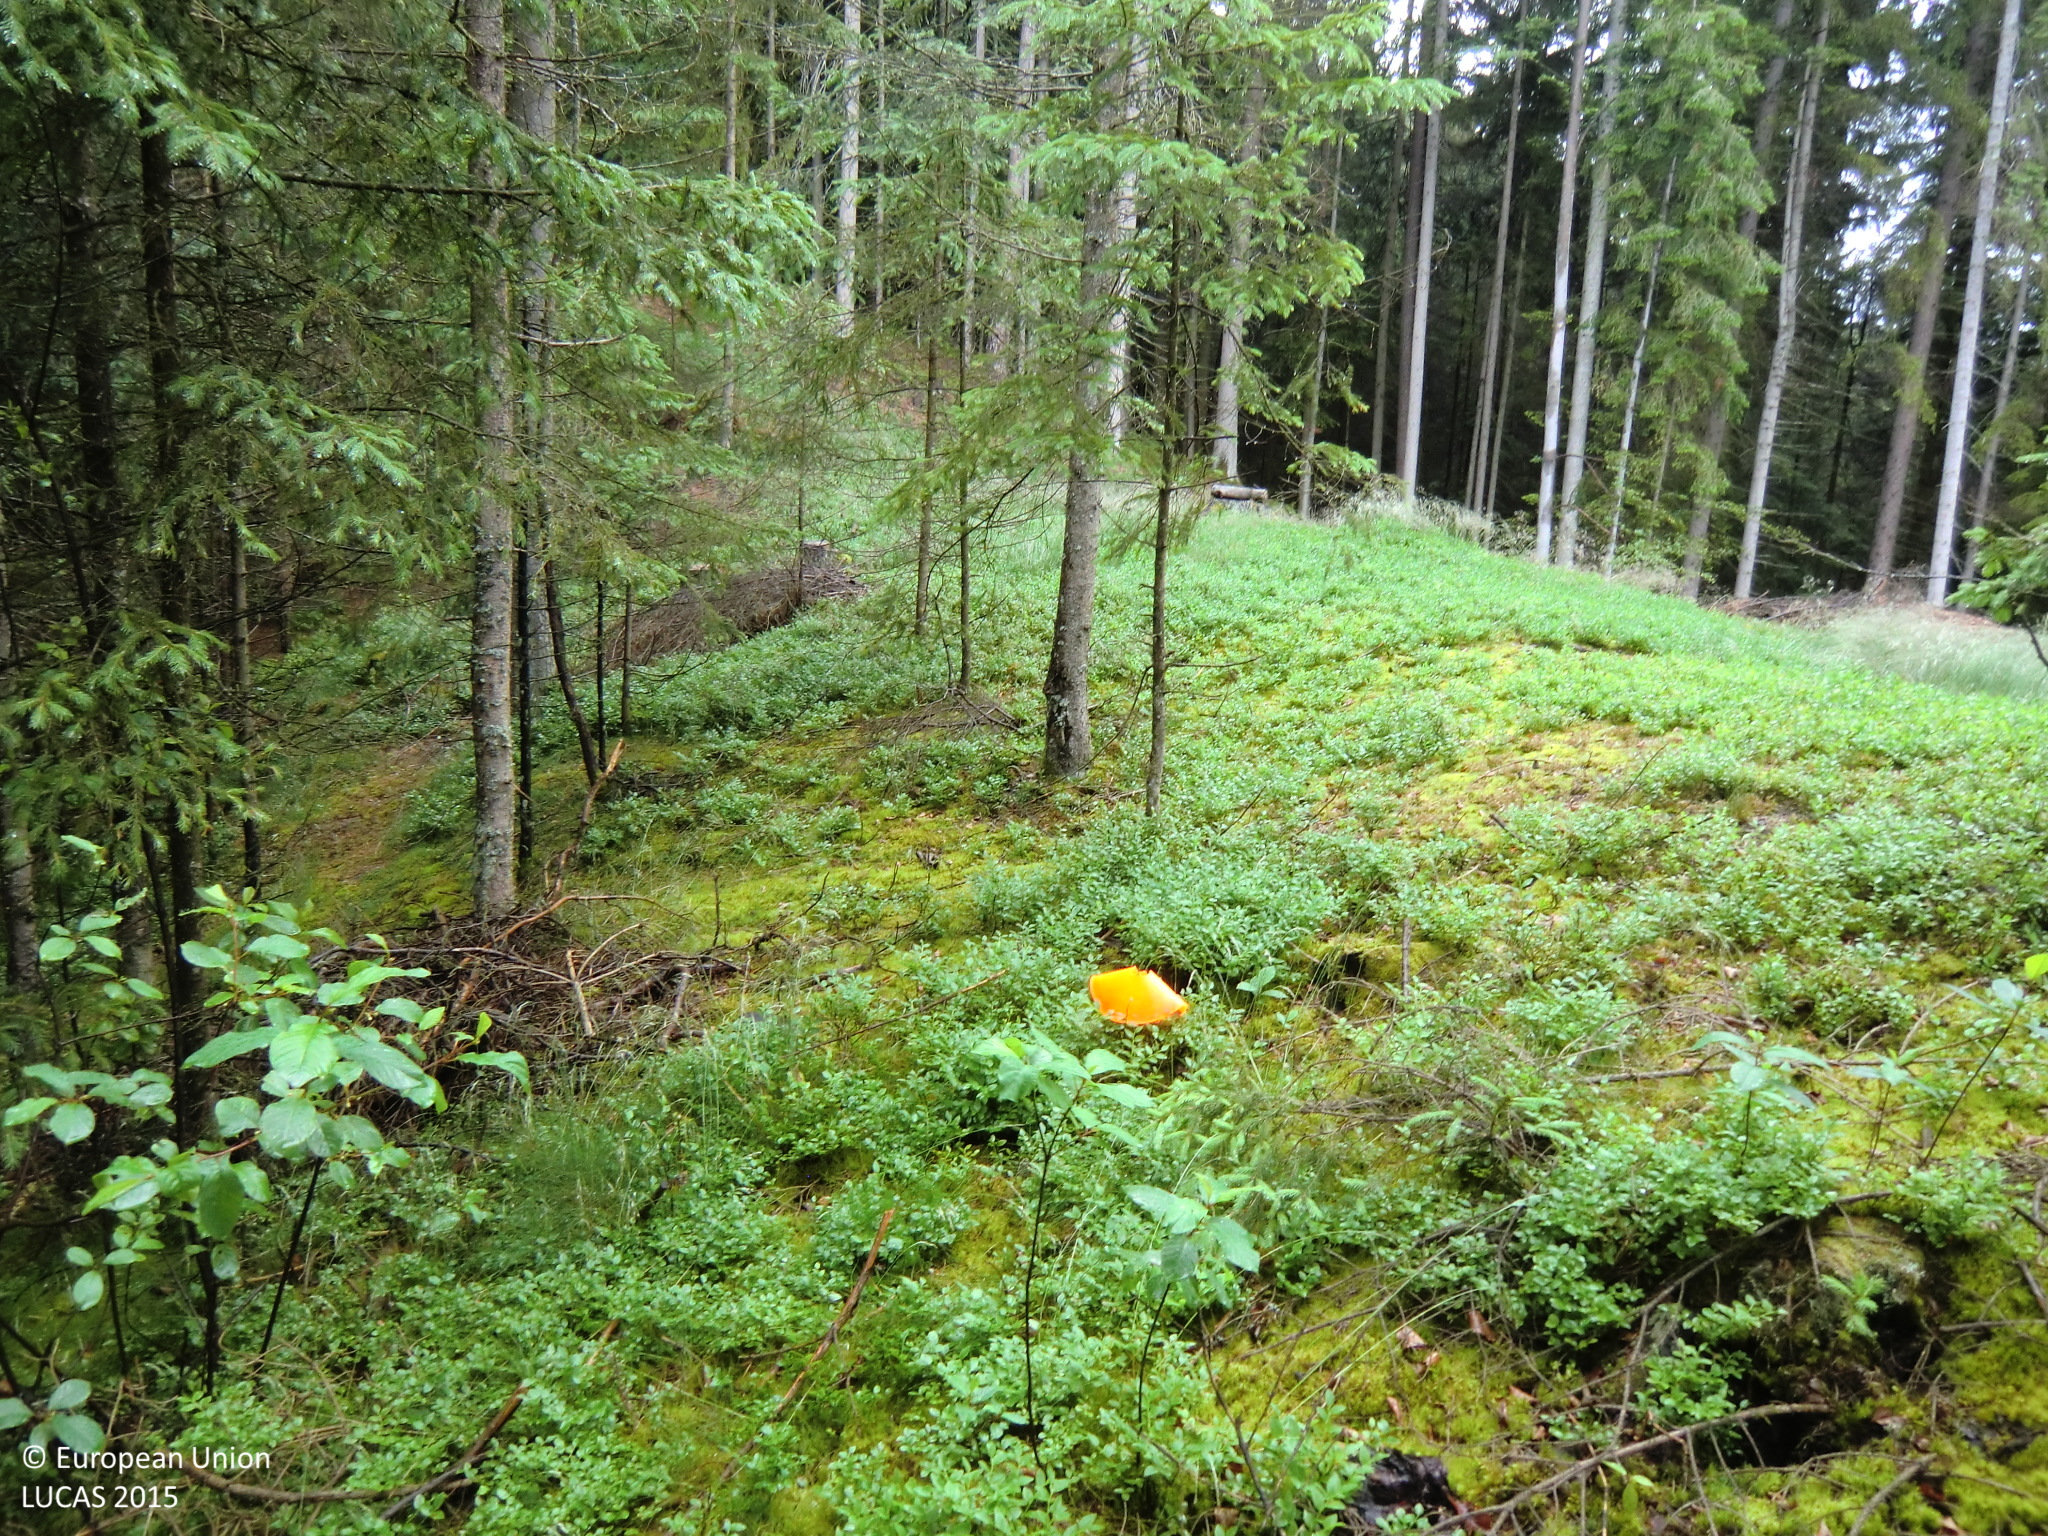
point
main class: Woodland
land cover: Spruce dominated coniferous woodland
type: hemiboreal forest and nemoral coniferous forest and mixed broadleaved-coniferous forest
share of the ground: 25 - 50 %
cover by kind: coniferous forest trees 45 %, shrubs 20 %, lichens and mosses 20 %, unconsolidated bare surface 10 %, herbaceous plants 5 %
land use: Forestry
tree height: > 5 m
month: June
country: AT
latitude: 48.4470
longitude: 14.7193
